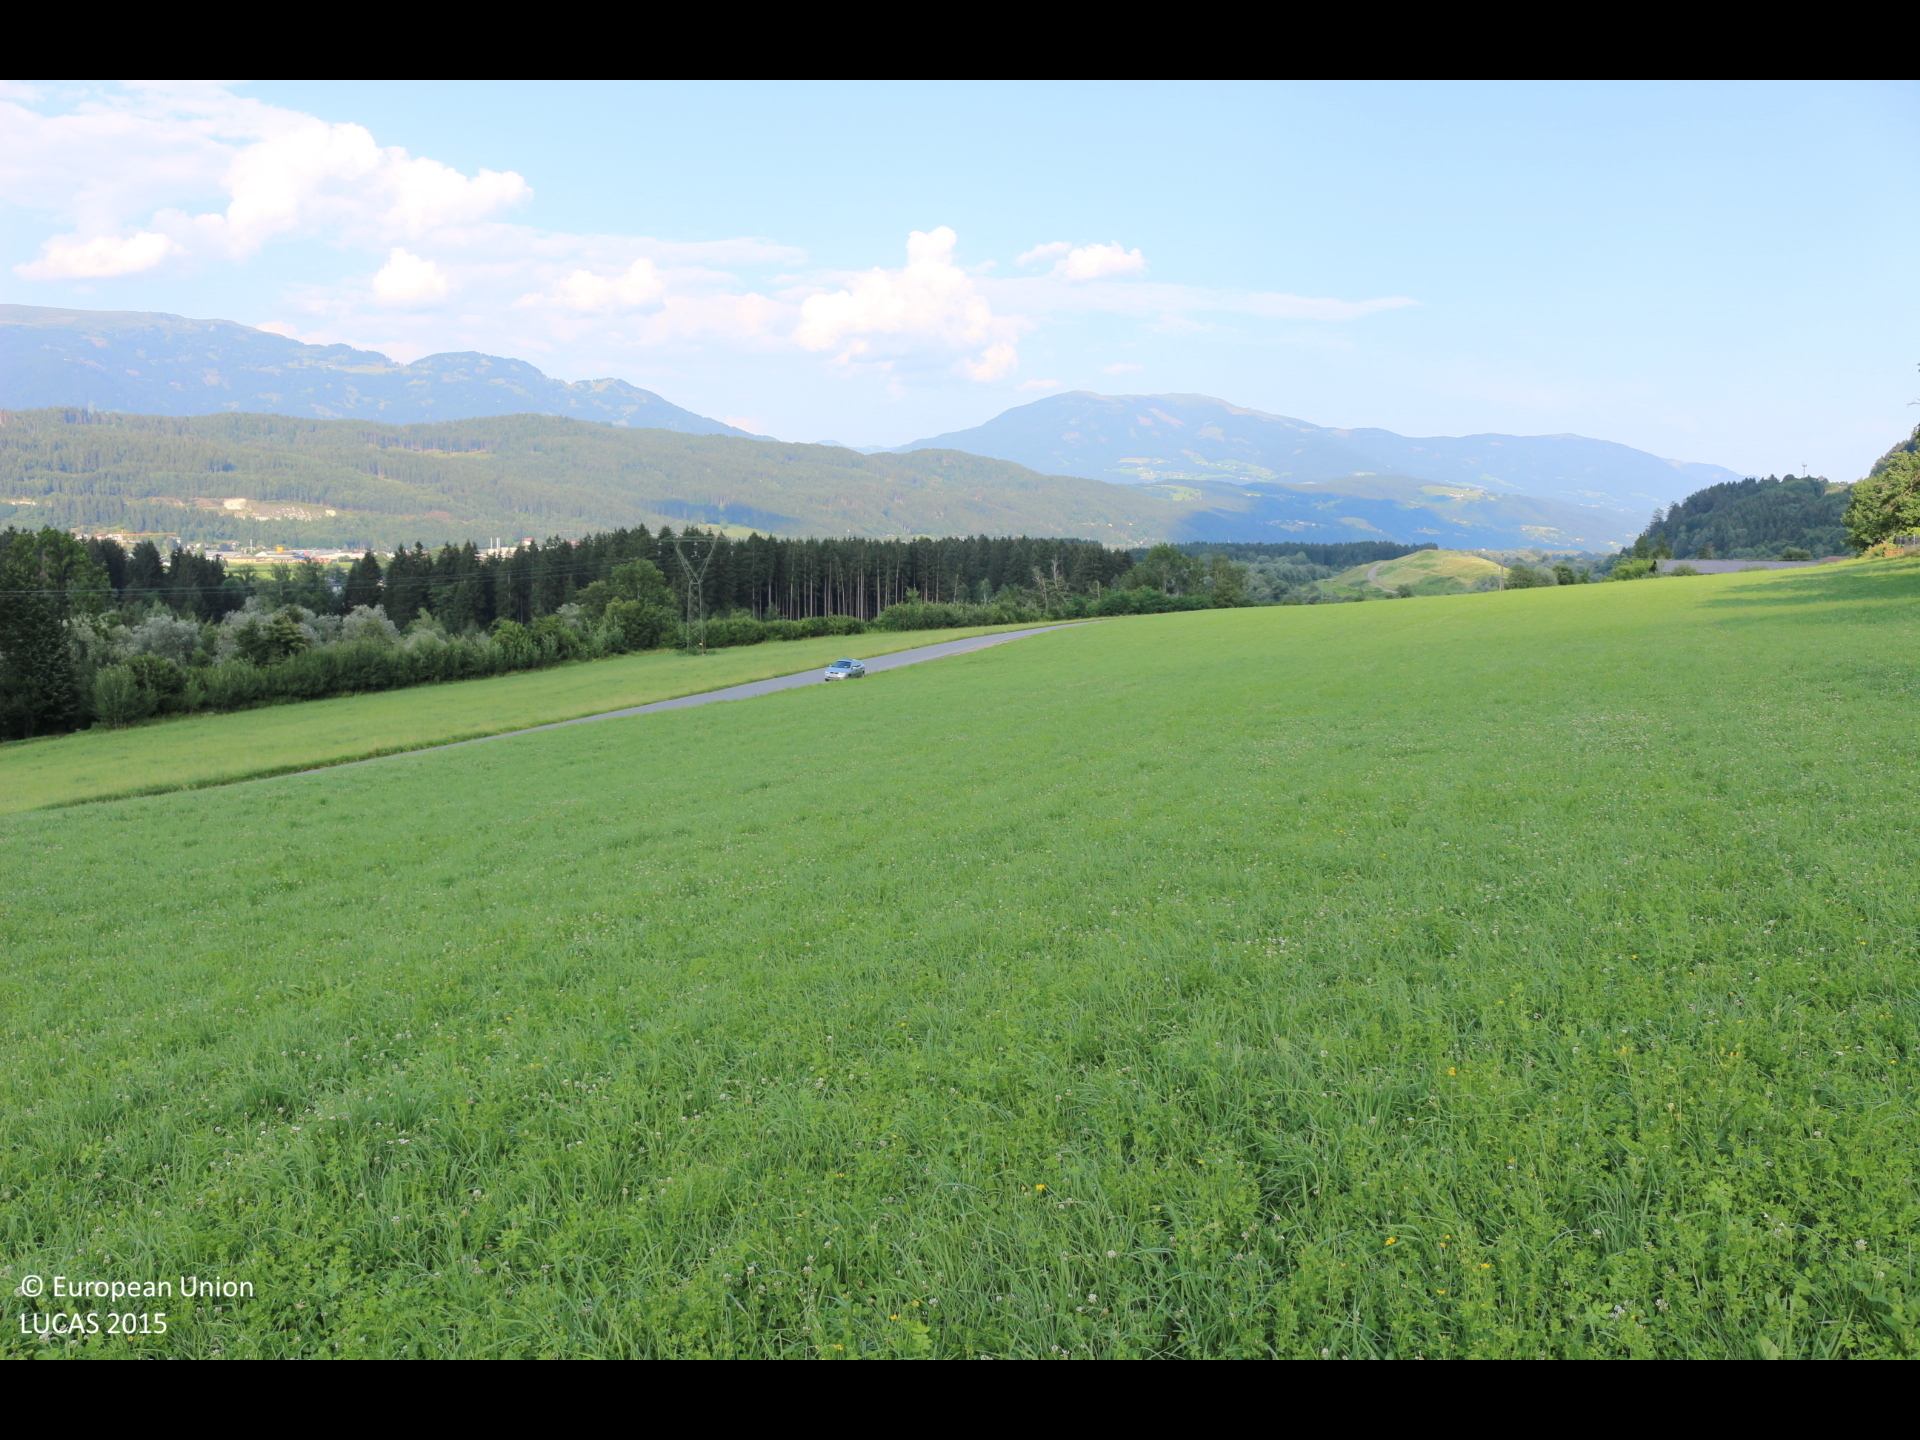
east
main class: Cropland
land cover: Temporary grasslands
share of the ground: > 75 %
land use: Agriculture (excluding fallow land and kitchen gardens)
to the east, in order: Temporary grasslands; Paved roads, cycling and walking lanes; Temporary grasslands
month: July
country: AT
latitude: 46.7809
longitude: 13.4945
